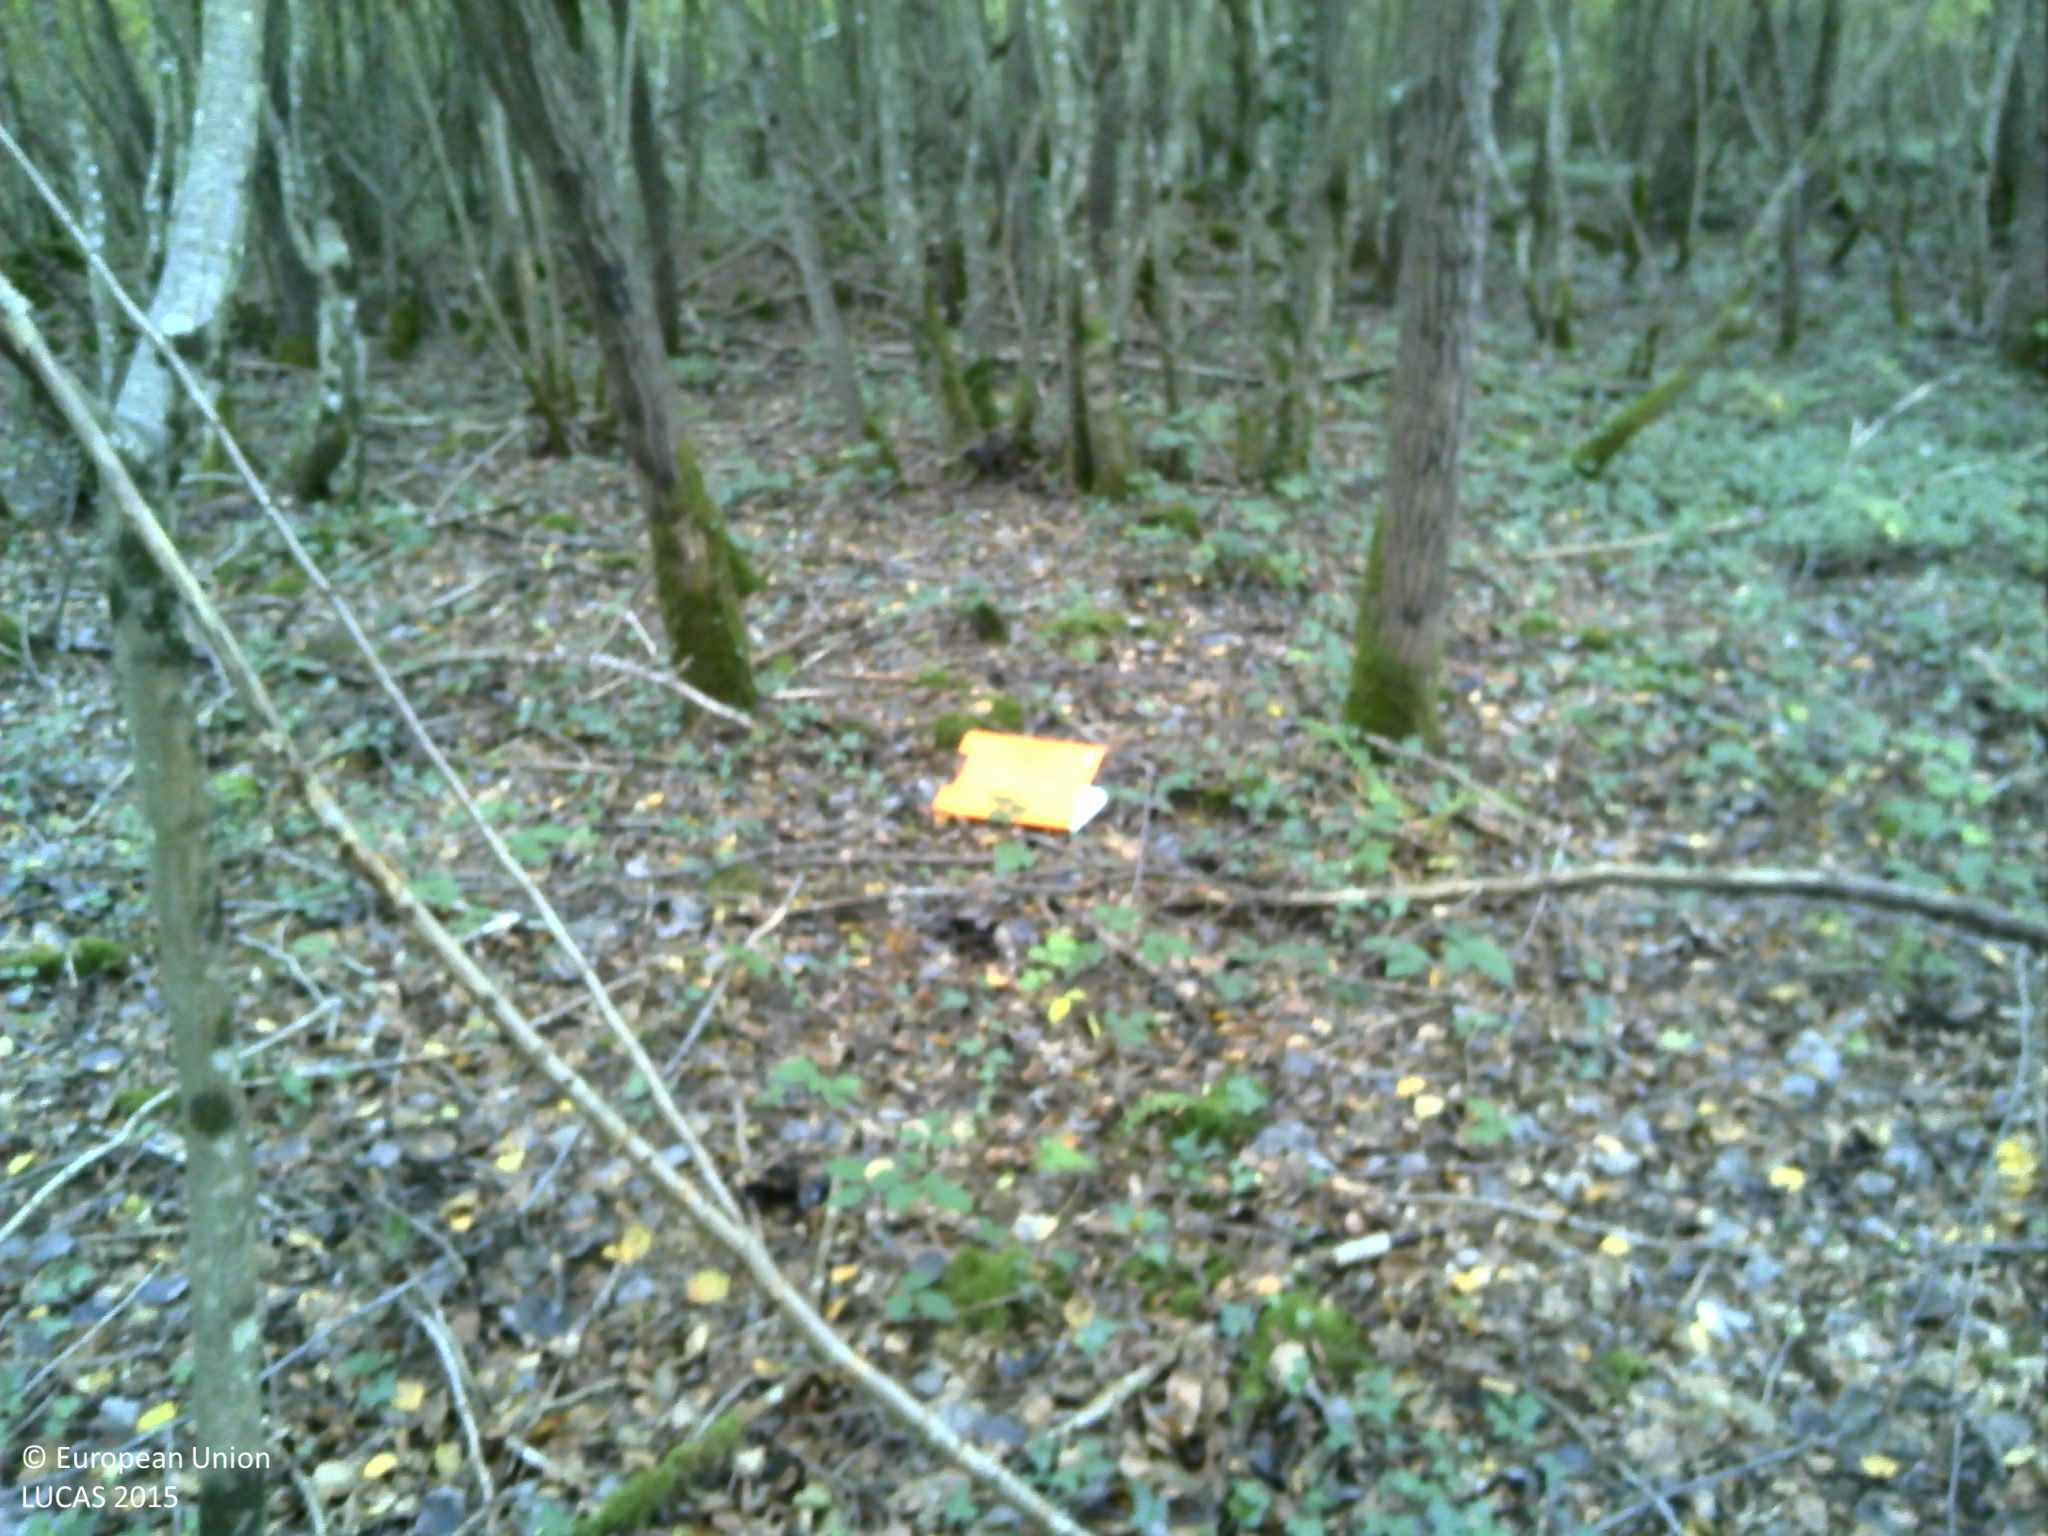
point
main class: Woodland
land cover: Broadleaved woodland
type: non-riverine alder, birch or aspen forest
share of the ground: > 75 %
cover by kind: broadleaved forest trees 85 %, herbaceous plants 10 %
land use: Forestry
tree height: > 5 m
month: October
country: FR
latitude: 46.8945
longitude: 4.8428
